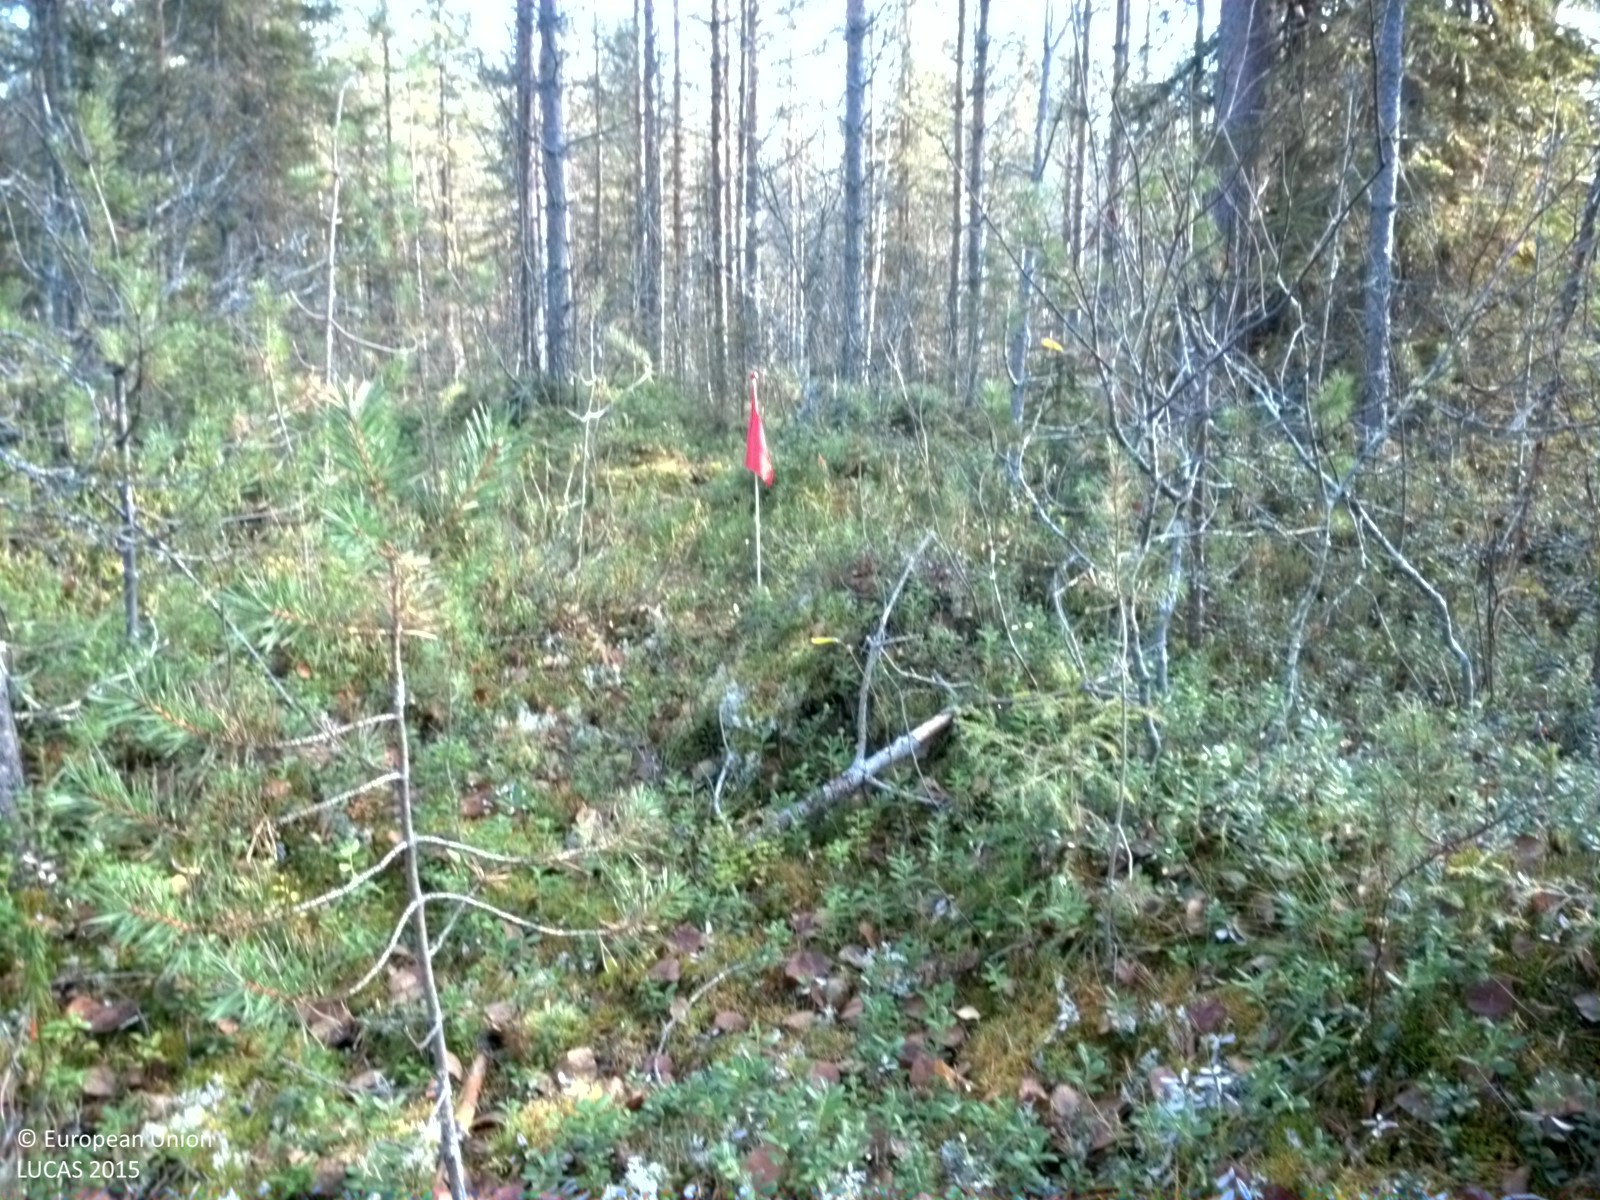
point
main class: Woodland
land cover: Pine dominated coniferous woodland
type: boreal forest
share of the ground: 25 - 50 %
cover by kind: shrubs 60 %, coniferous forest trees 35 %, broadleaved forest trees 5 %
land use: Forestry
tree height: > 5 m
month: October
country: SE
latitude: 65.9587
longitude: 22.2286
